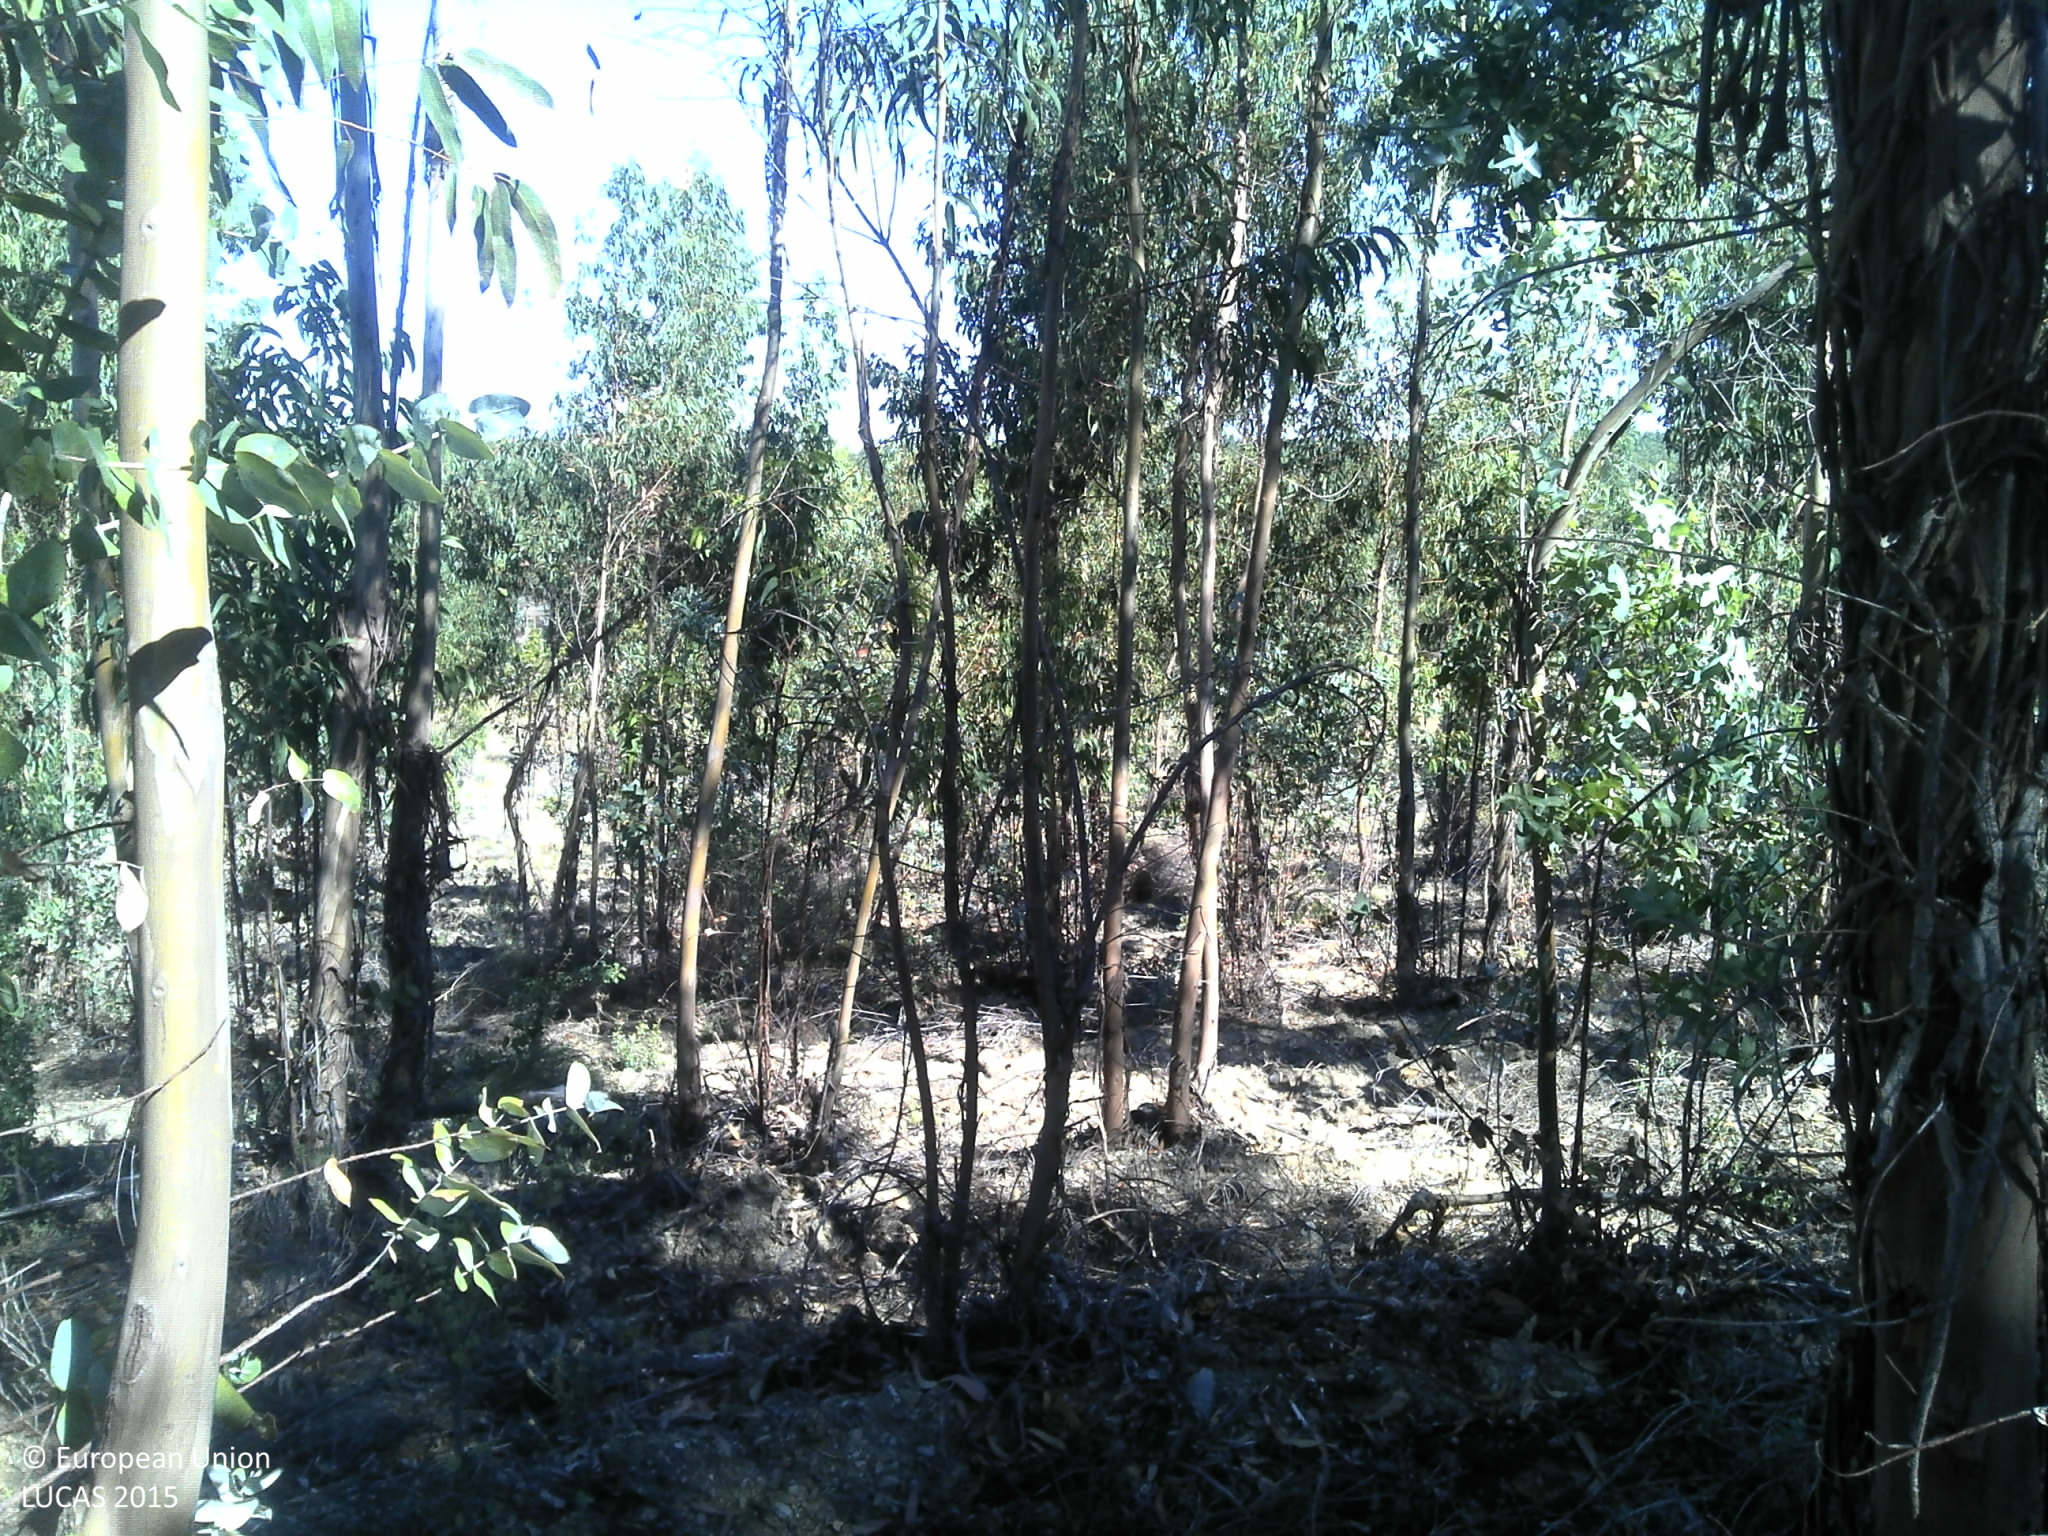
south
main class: Woodland
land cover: Broadleaved woodland
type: exotic forest
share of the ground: 50 - 75 %
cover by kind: broadleaved forest trees 75 %, unconsolidated bare surface 15 %, shrubs 5 %
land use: Forestry
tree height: > 5 m
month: June
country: PT
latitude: 40.0416
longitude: -7.2198
